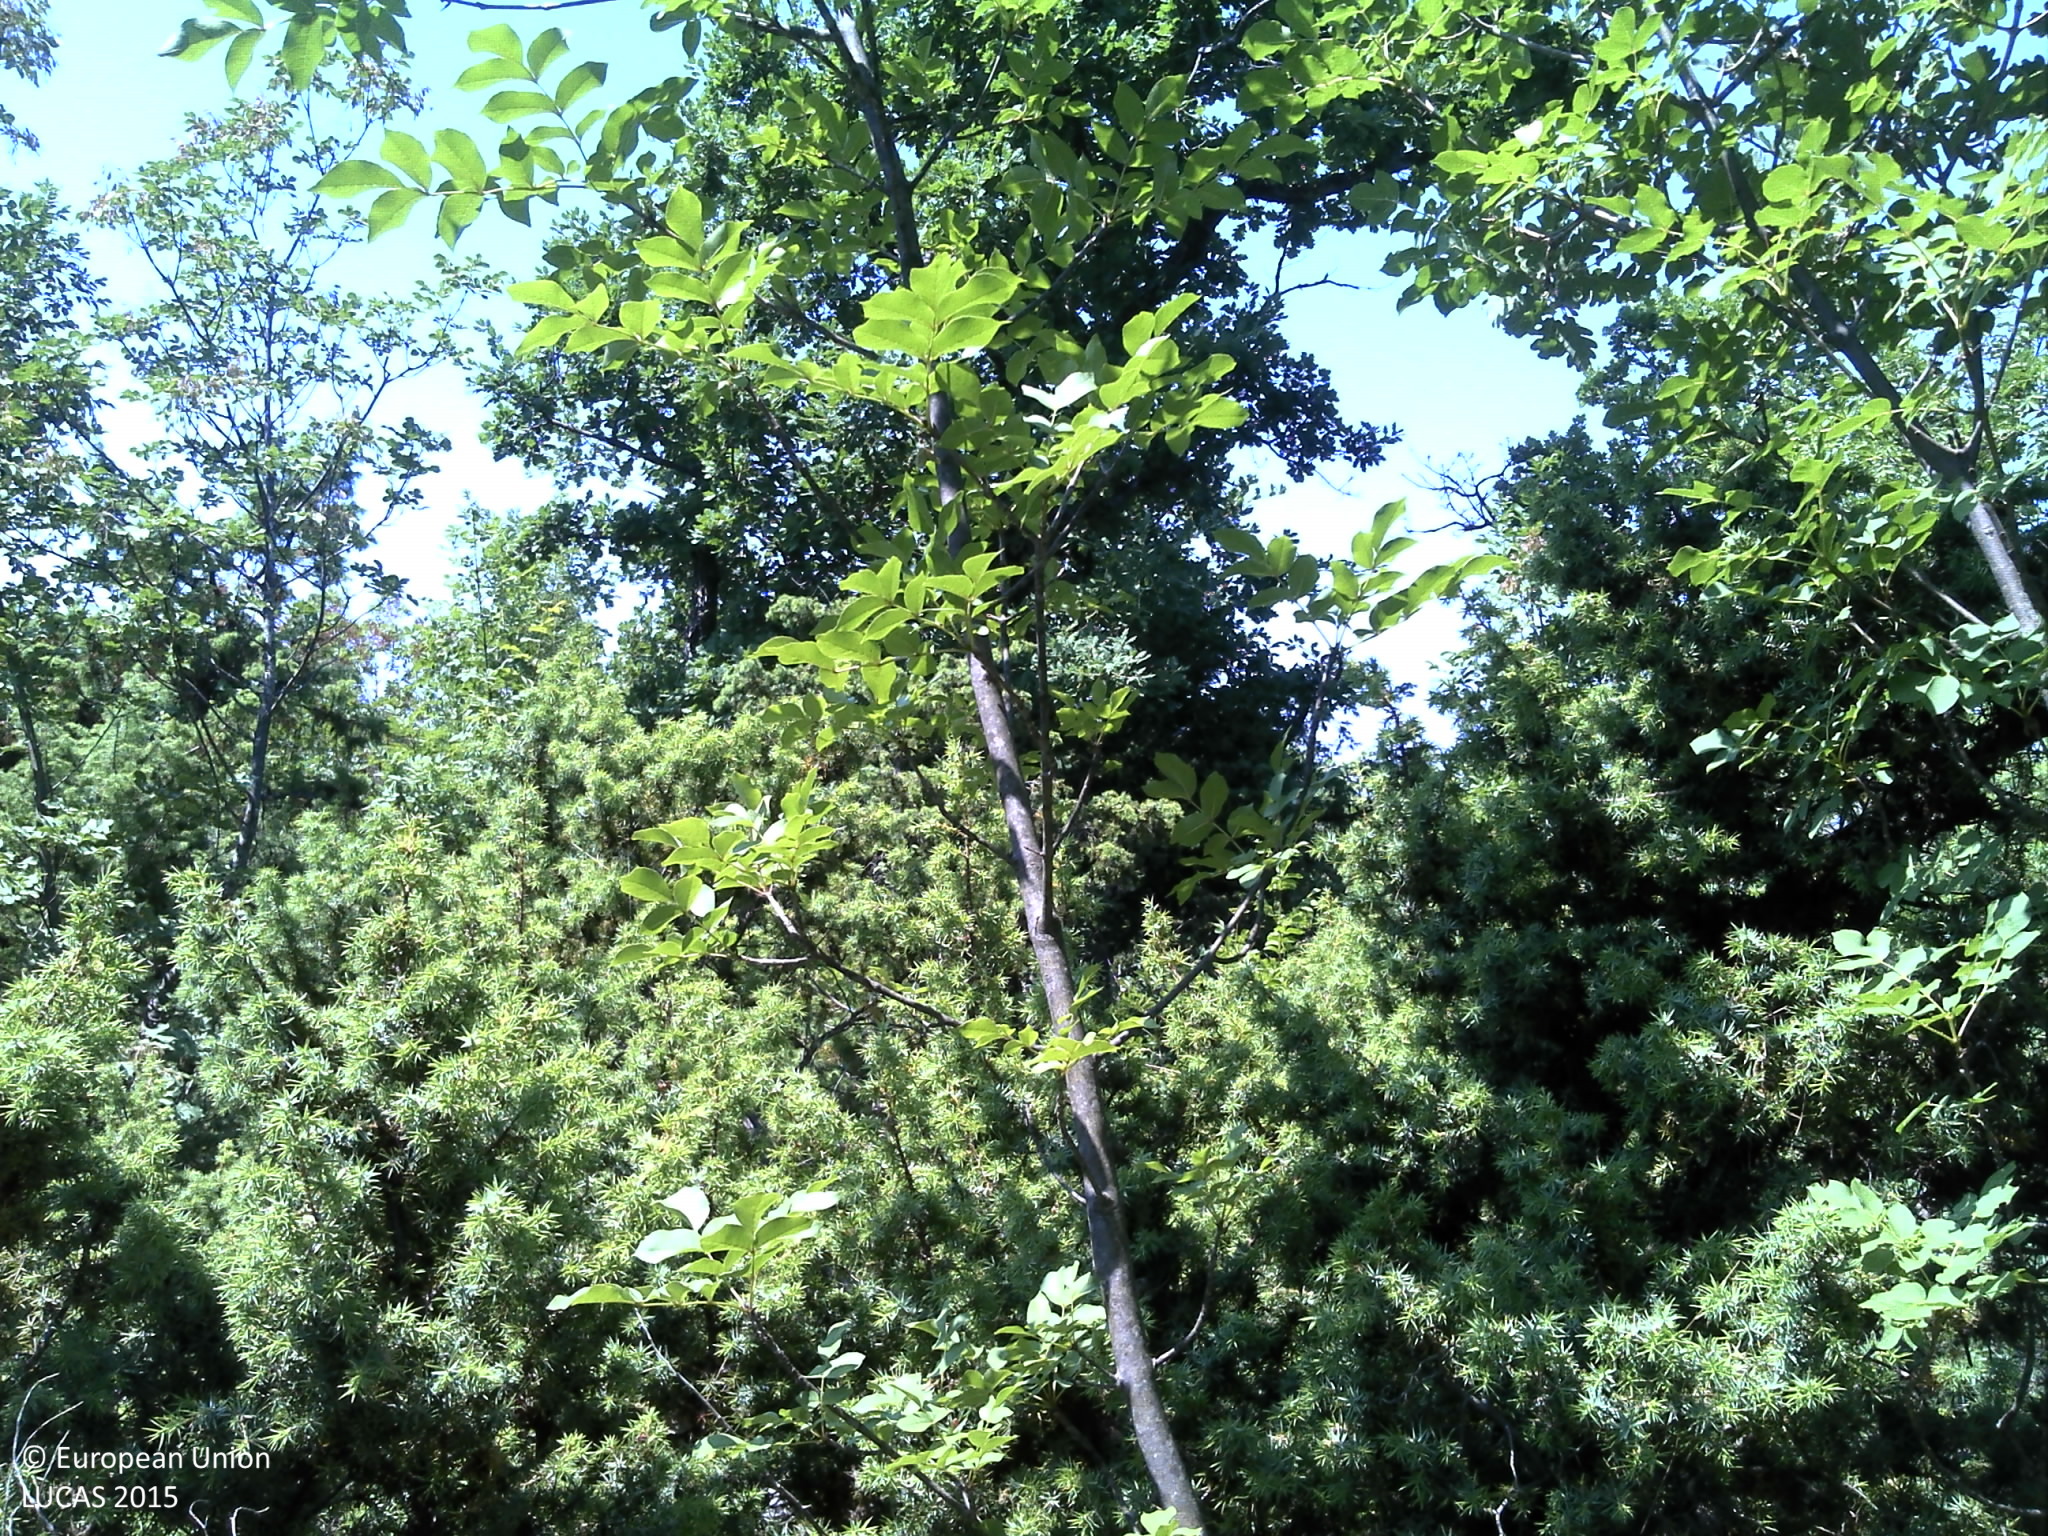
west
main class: Woodland
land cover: Broadleaved woodland
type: thermophilous deciduous forest
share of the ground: 50 - 75 %
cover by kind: broadleaved forest trees 60 %, shrubs 20 %, unconsolidated bare surface 15 %, lichens and mosses 5 %
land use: Semi-natural and natural areas not in use
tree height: > 5 m
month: June
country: HR
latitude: 43.5759
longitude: 16.0707
